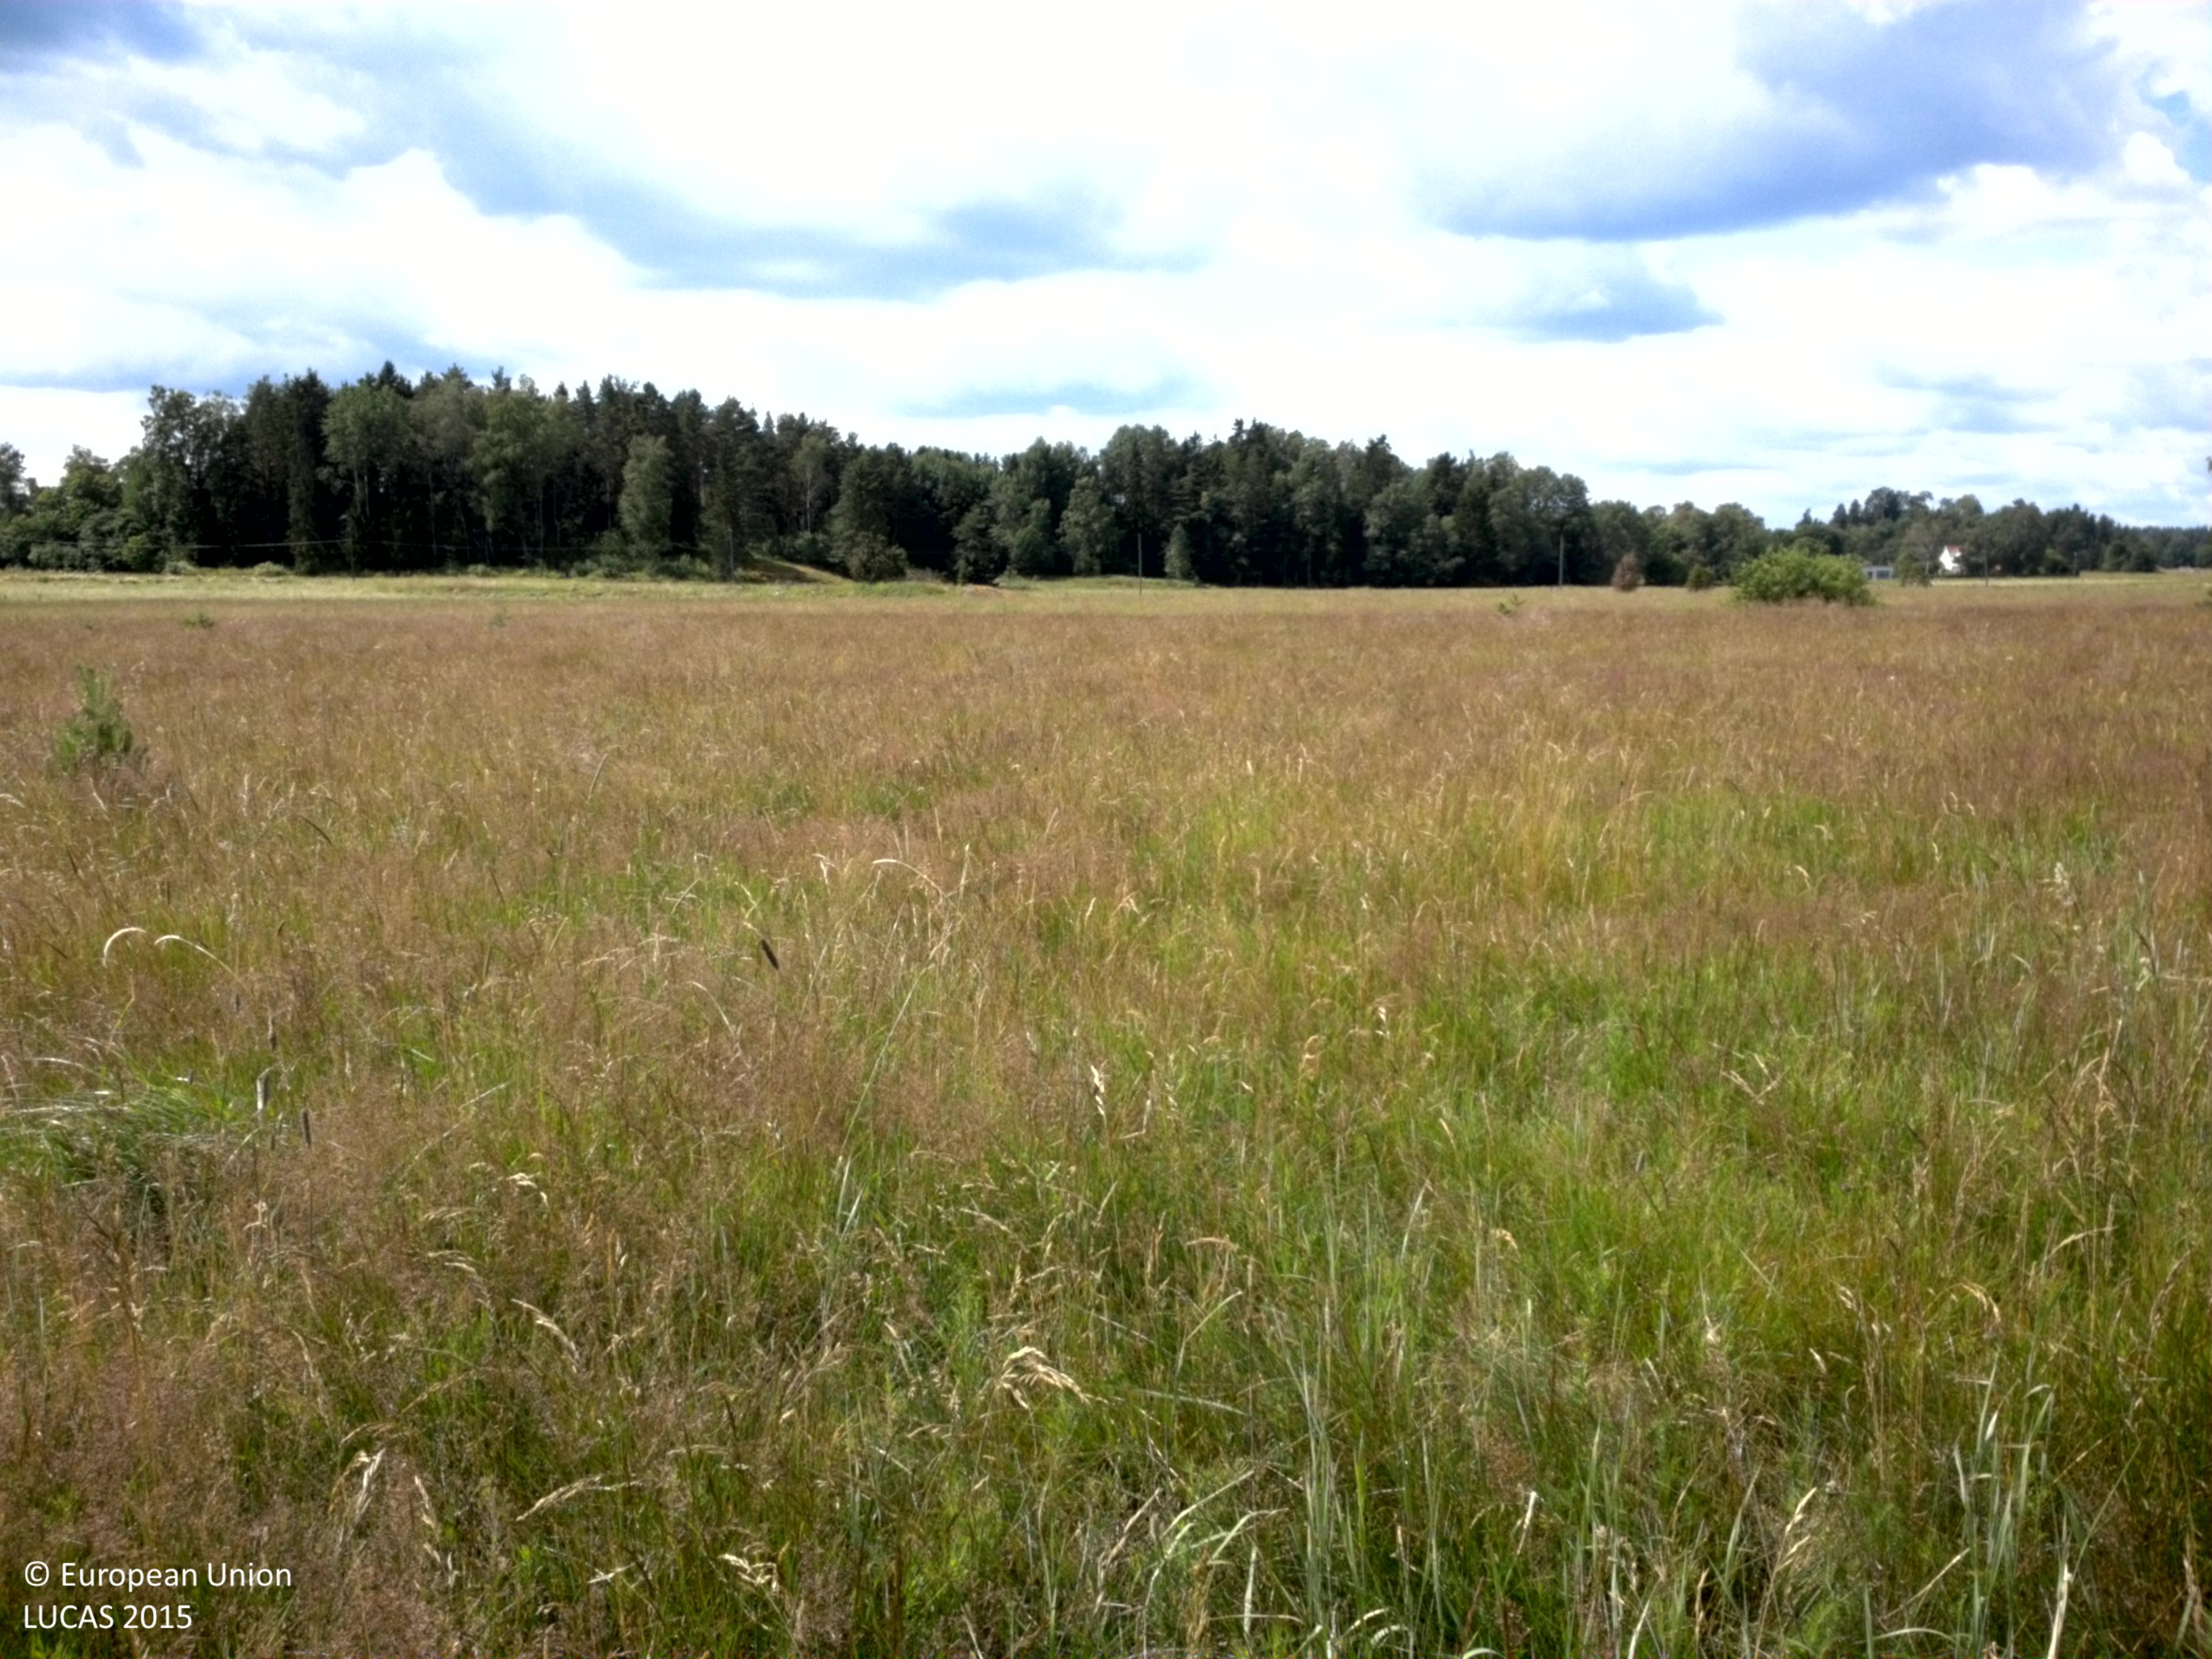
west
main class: Grassland
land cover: Grassland without tree/shrub cover
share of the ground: > 75 %
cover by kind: herbaceous plants 100 %
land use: Agriculture (excluding fallow land and kitchen gardens)
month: July
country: SE
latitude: 59.6322
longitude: 18.5296
